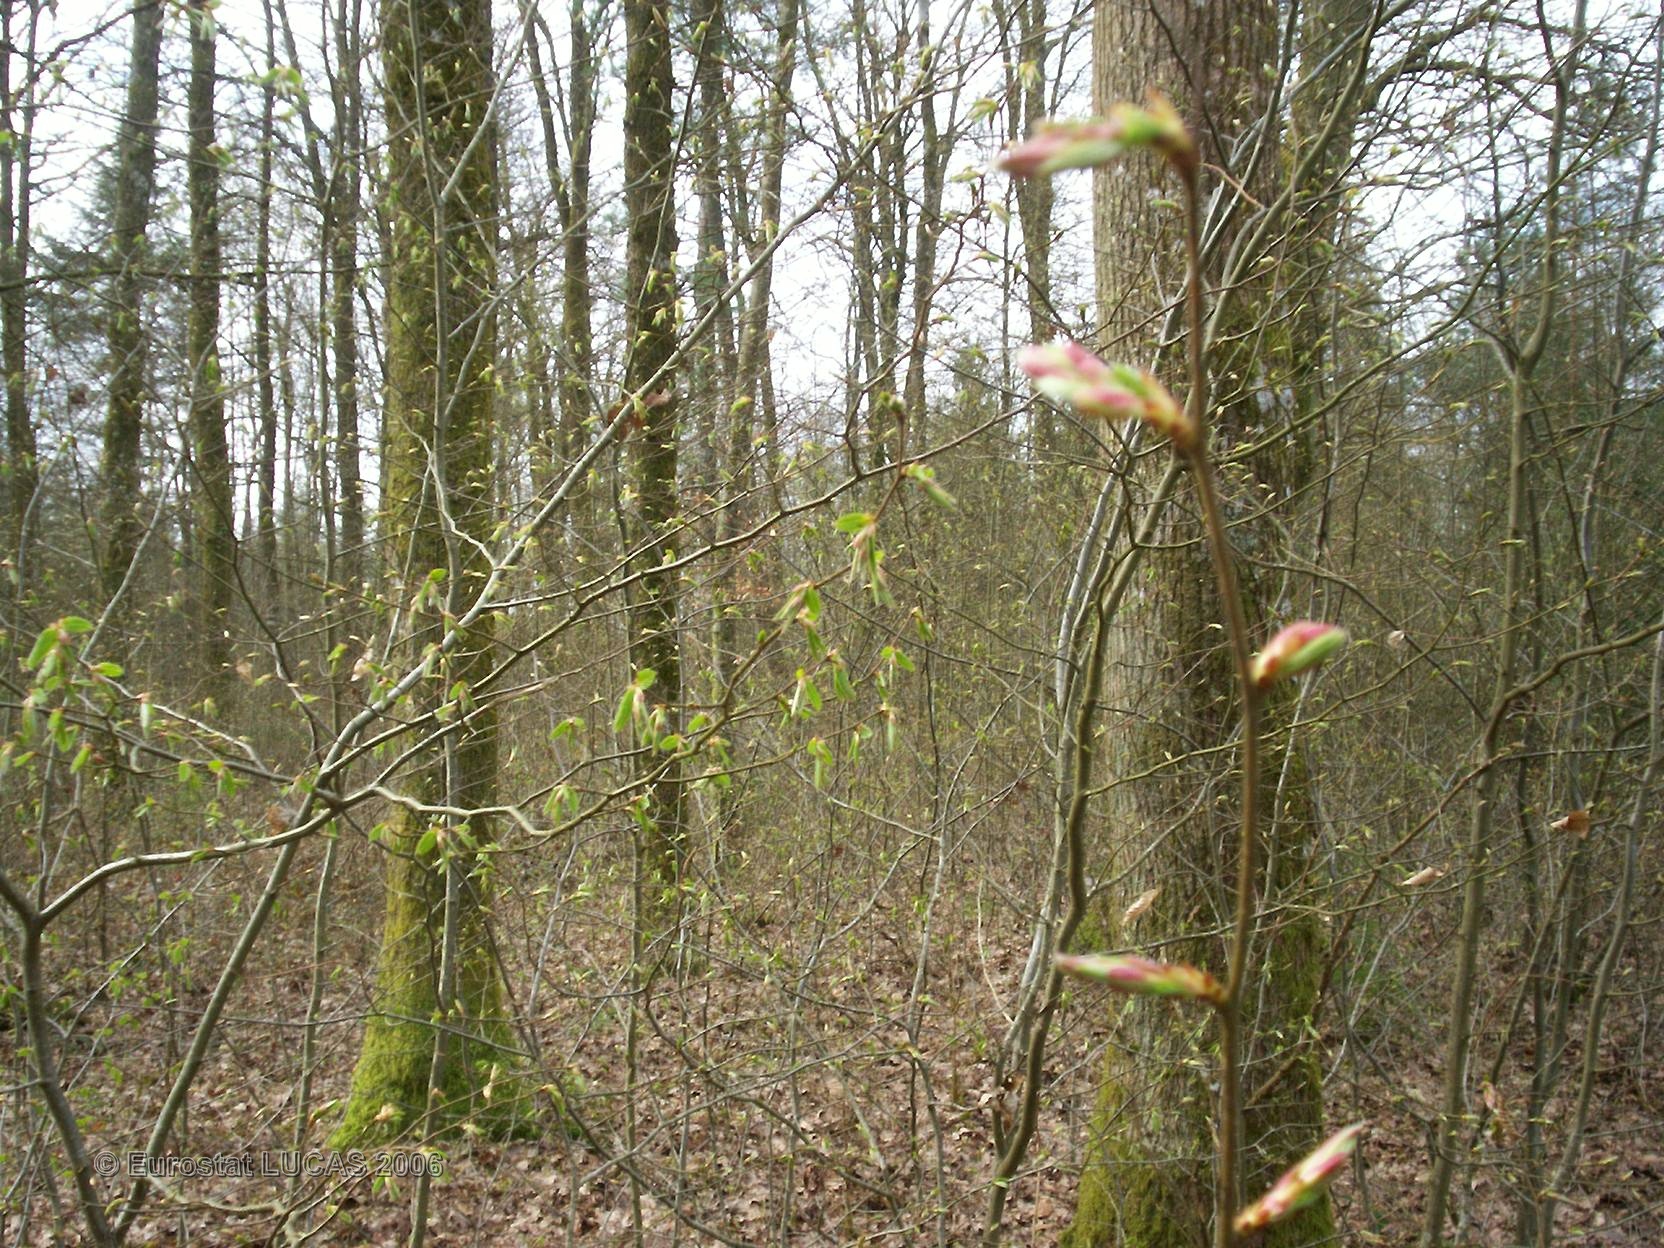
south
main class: Woodland
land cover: Broadleaved forest
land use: Forestry
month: April
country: FR
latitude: 48.0804
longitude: 6.0406
